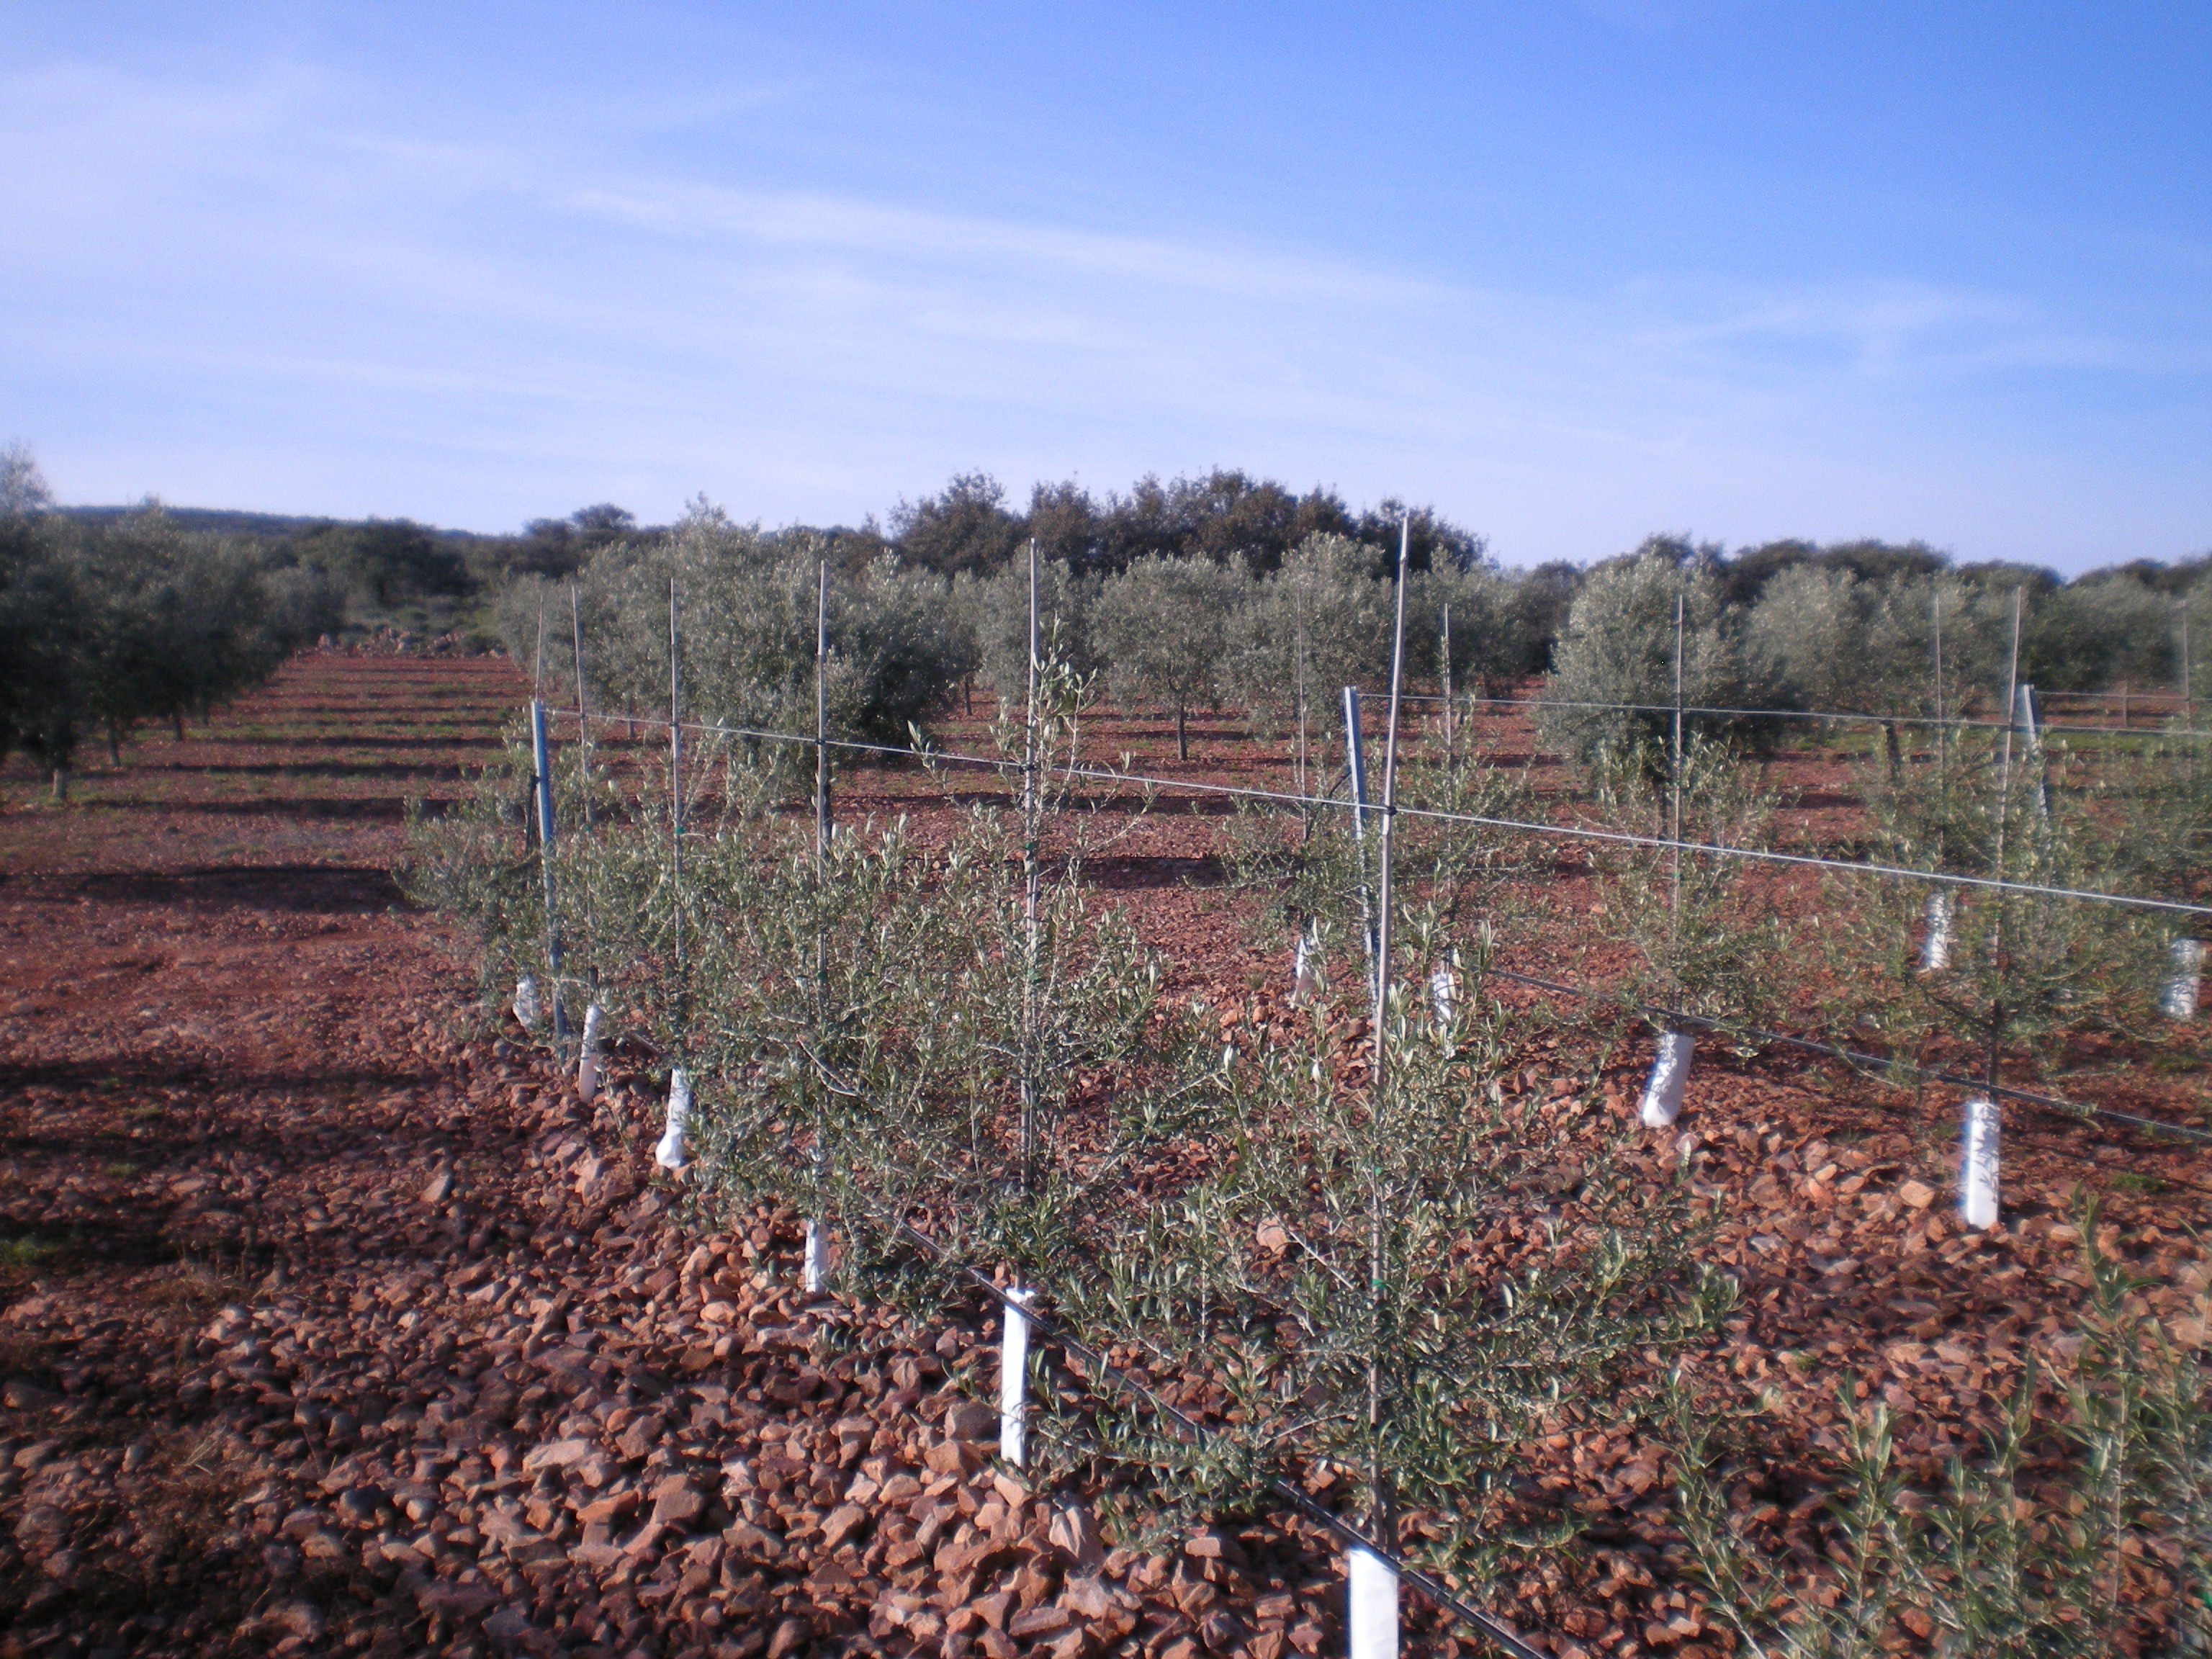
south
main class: Cropland
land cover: Olive groves
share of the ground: 10 - 25 %
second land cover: Other bare soil
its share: > 75 %
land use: Agriculture (excluding fallow land and kitchen gardens)
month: April
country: ES
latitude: 38.8781
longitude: -3.5821
